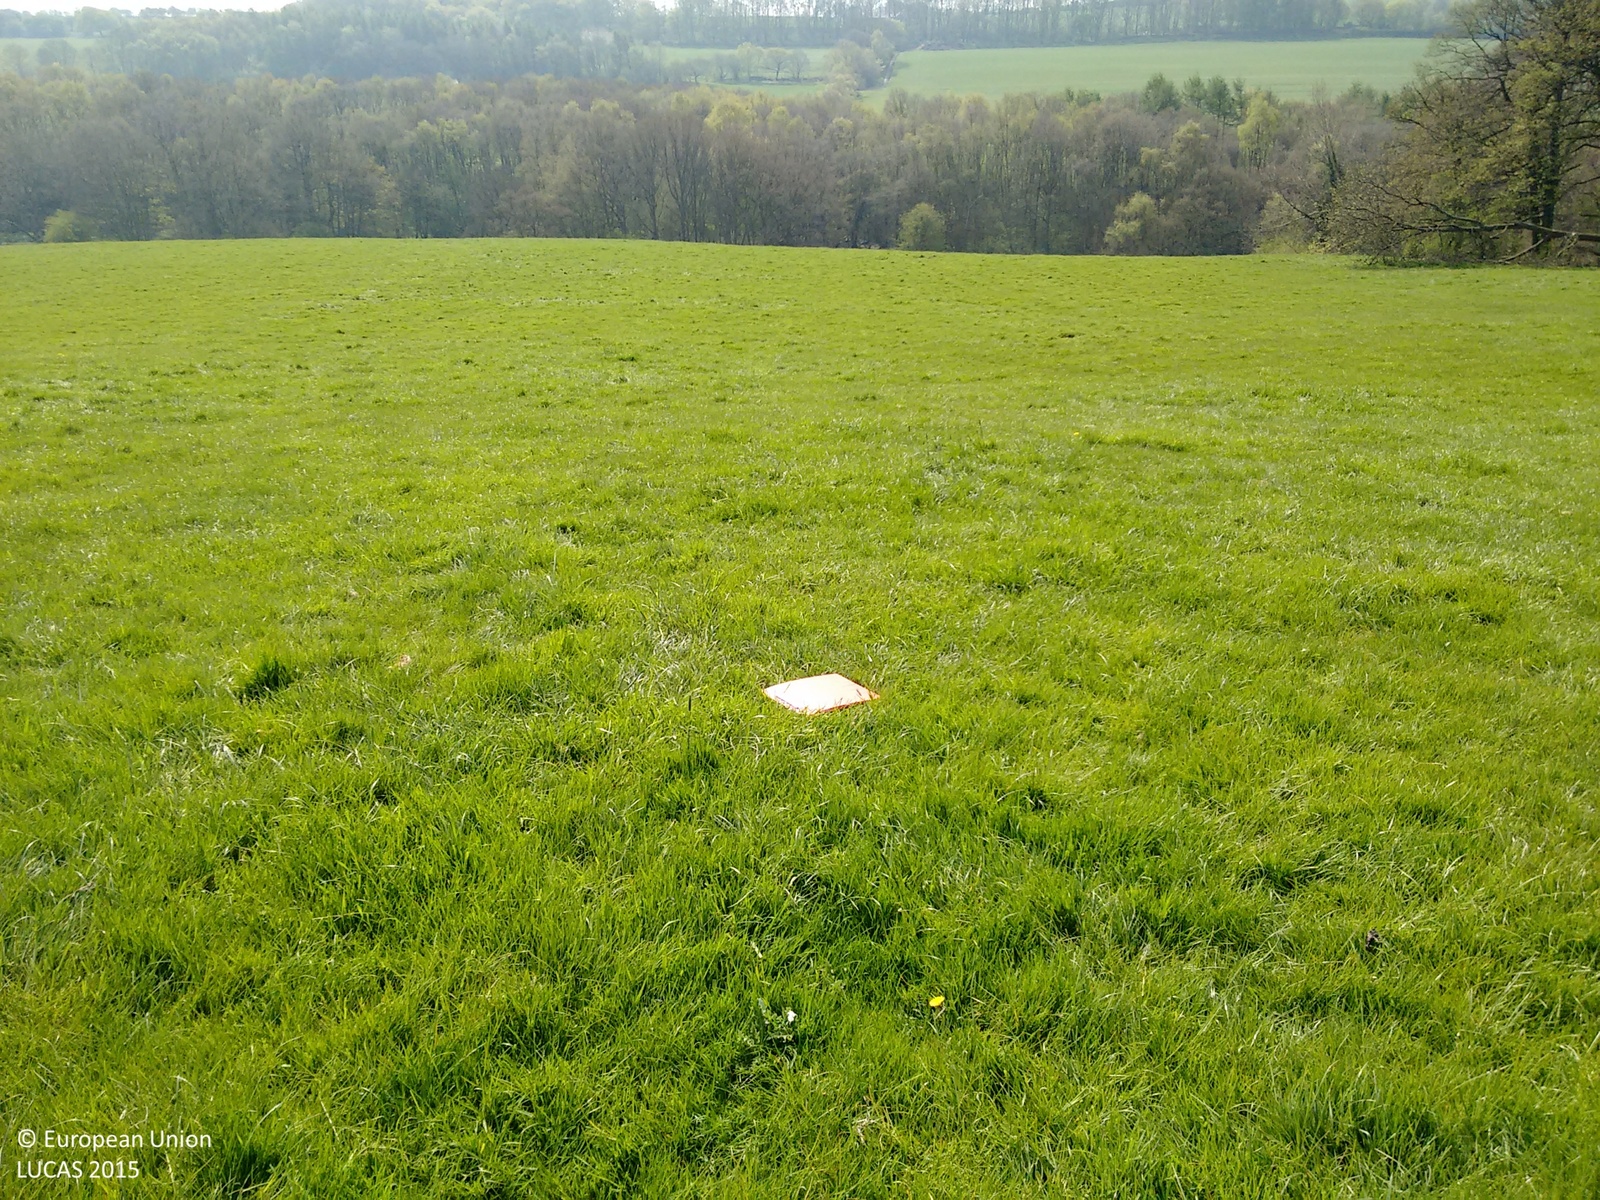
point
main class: Grassland
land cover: Grassland without tree/shrub cover
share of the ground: > 75 %
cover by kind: herbaceous plants 100 %
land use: Agriculture (excluding fallow land and kitchen gardens)
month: April
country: GB
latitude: 53.7813
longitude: -1.6618
